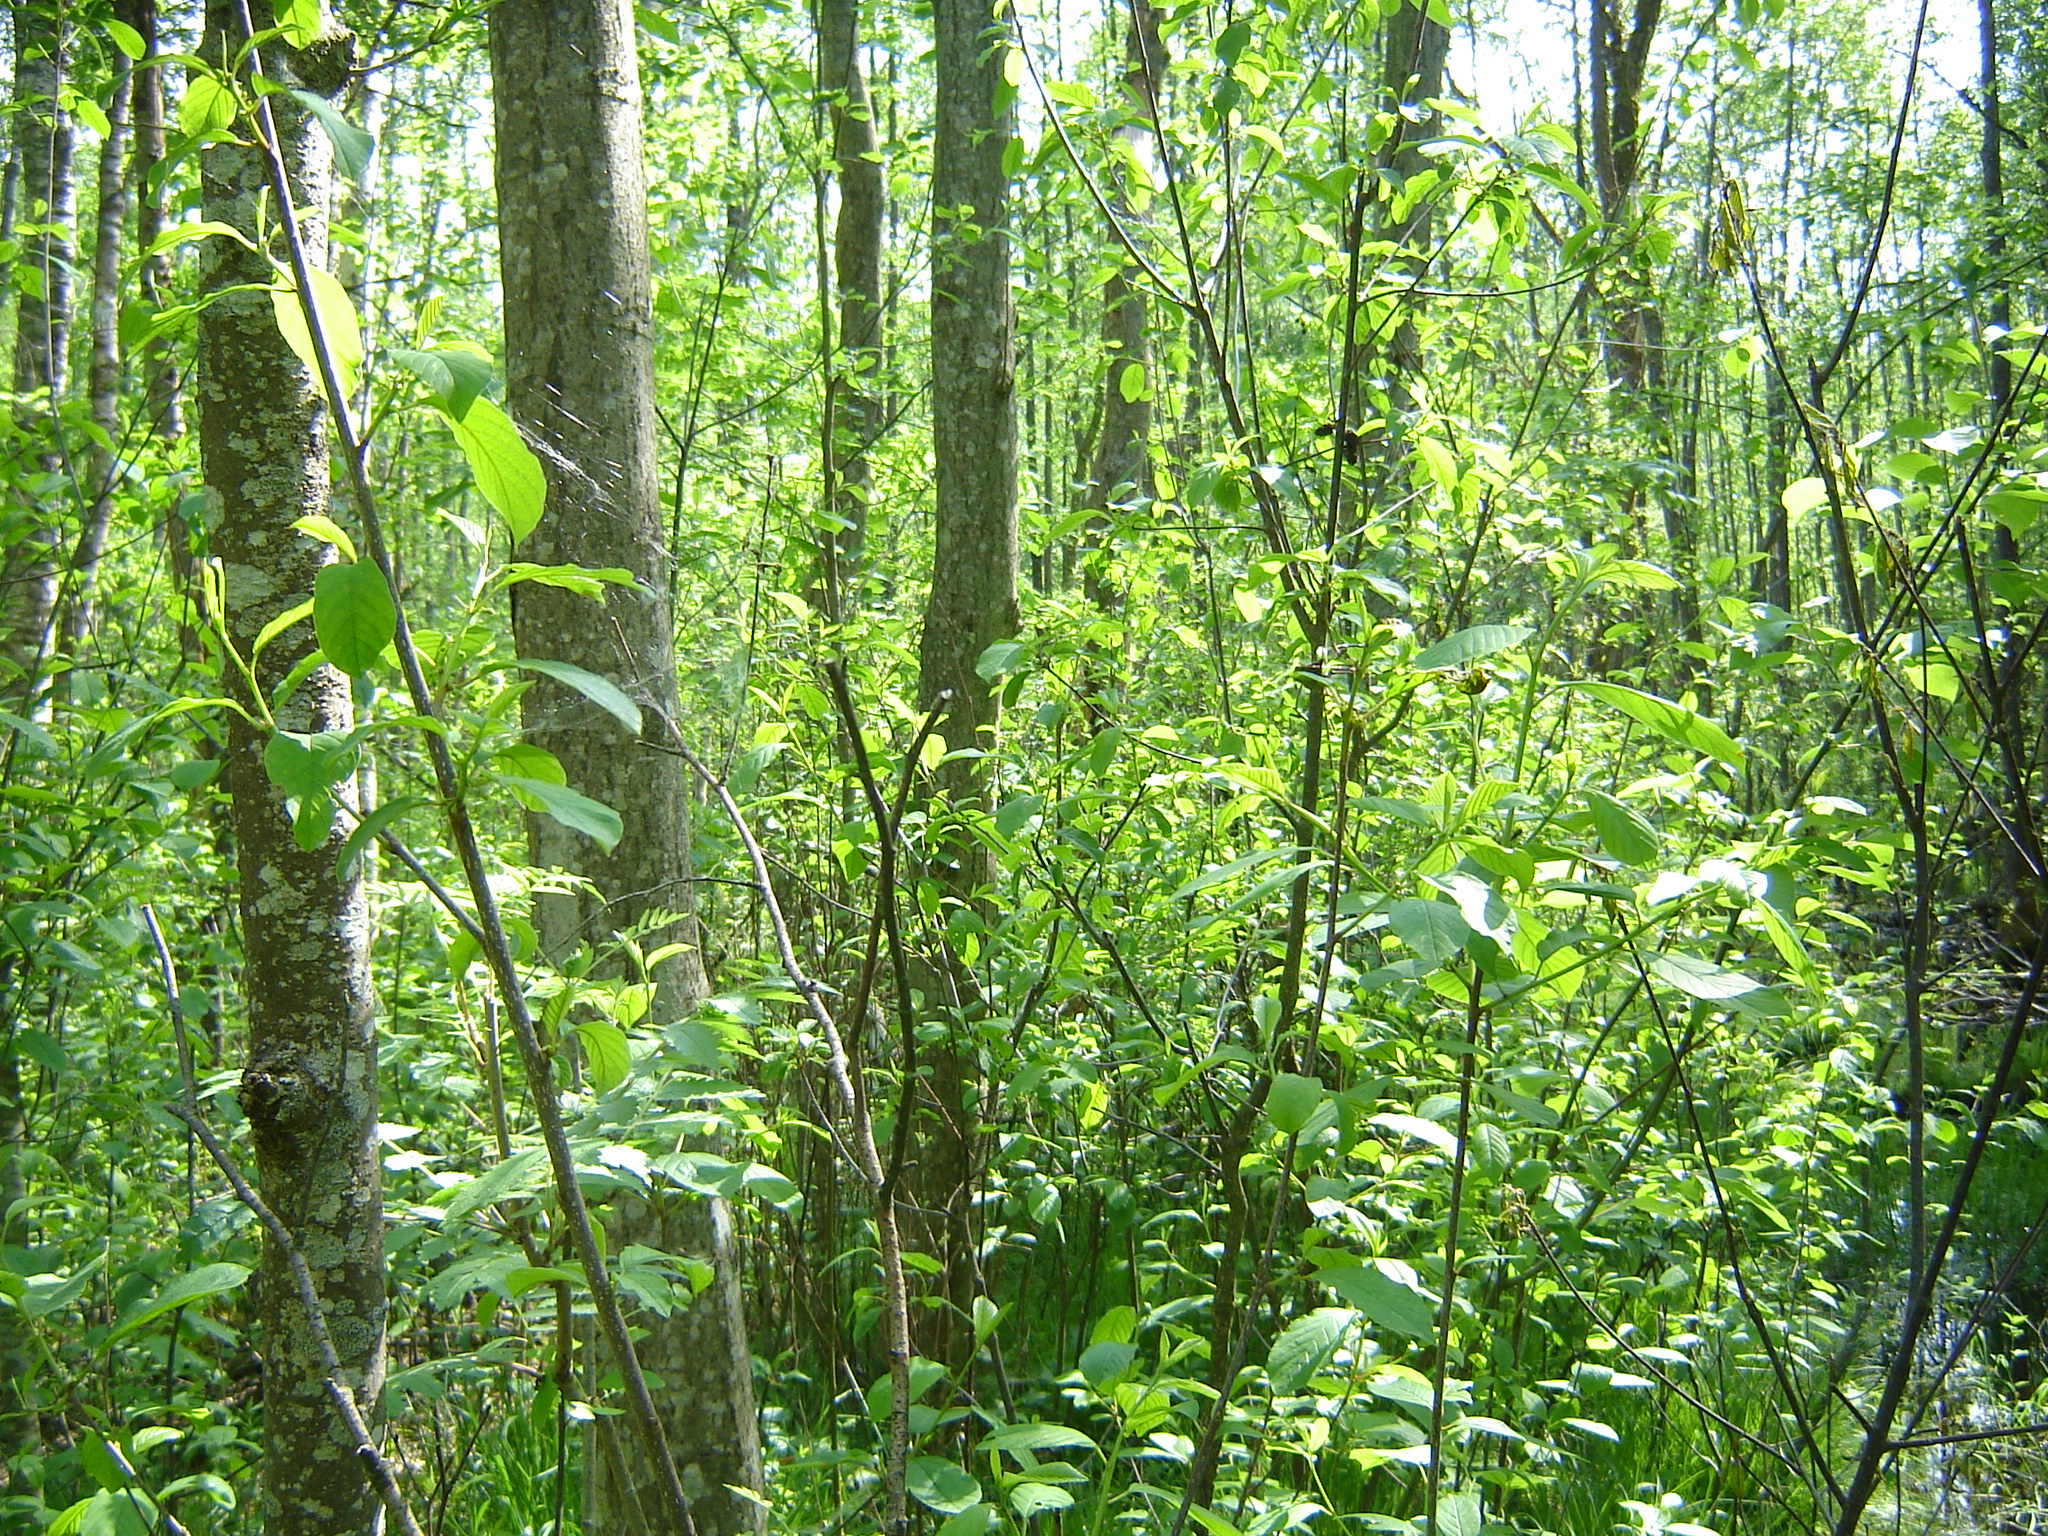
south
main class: Woodland
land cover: Broadleaved woodland
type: floodplain forest
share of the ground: > 75 %
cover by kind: broadleaved forest trees 90 %, herbaceous plants 10 %
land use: Forestry
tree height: > 5 m
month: June
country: LT
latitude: 55.9220
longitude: 25.3041
